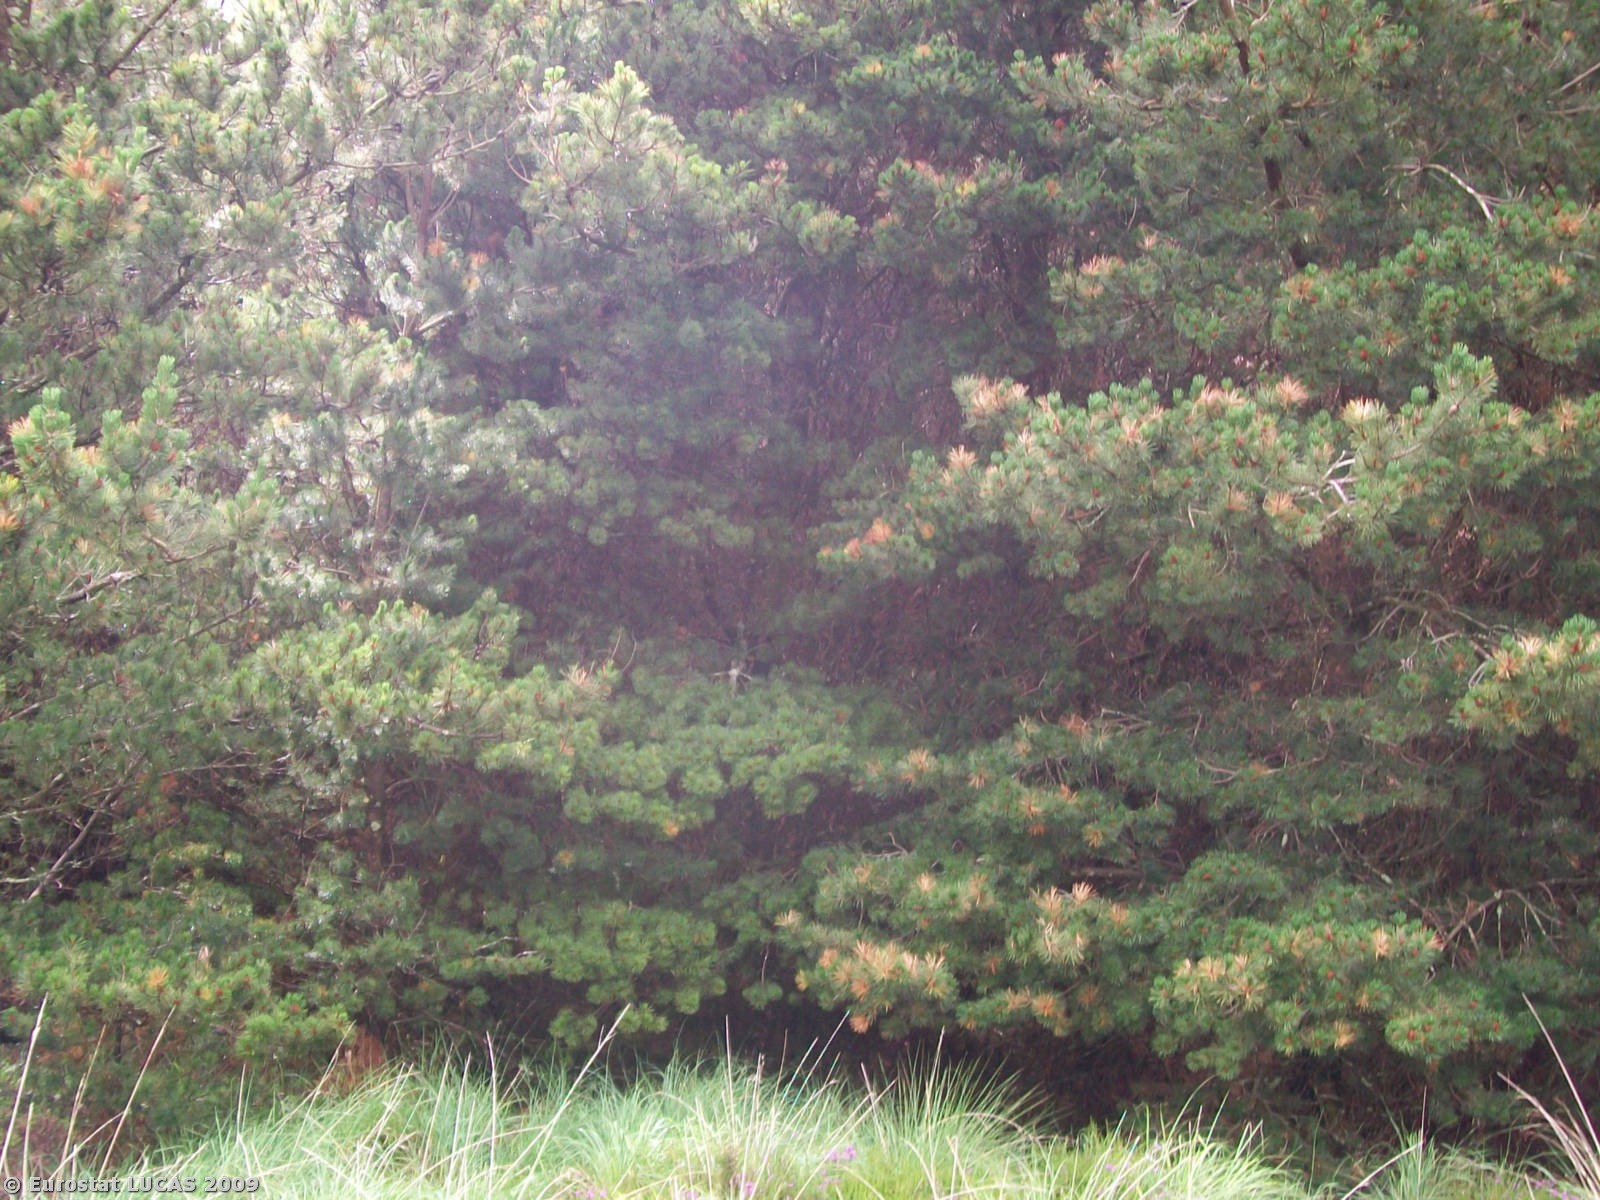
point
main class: Woodland
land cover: Coniferous woodland
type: plantations and self-sown exotic forest
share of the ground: > 75 %
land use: Forestry
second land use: Nature reserves
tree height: > 5 m
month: July
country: IE
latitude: 54.0814
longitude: -9.7942
